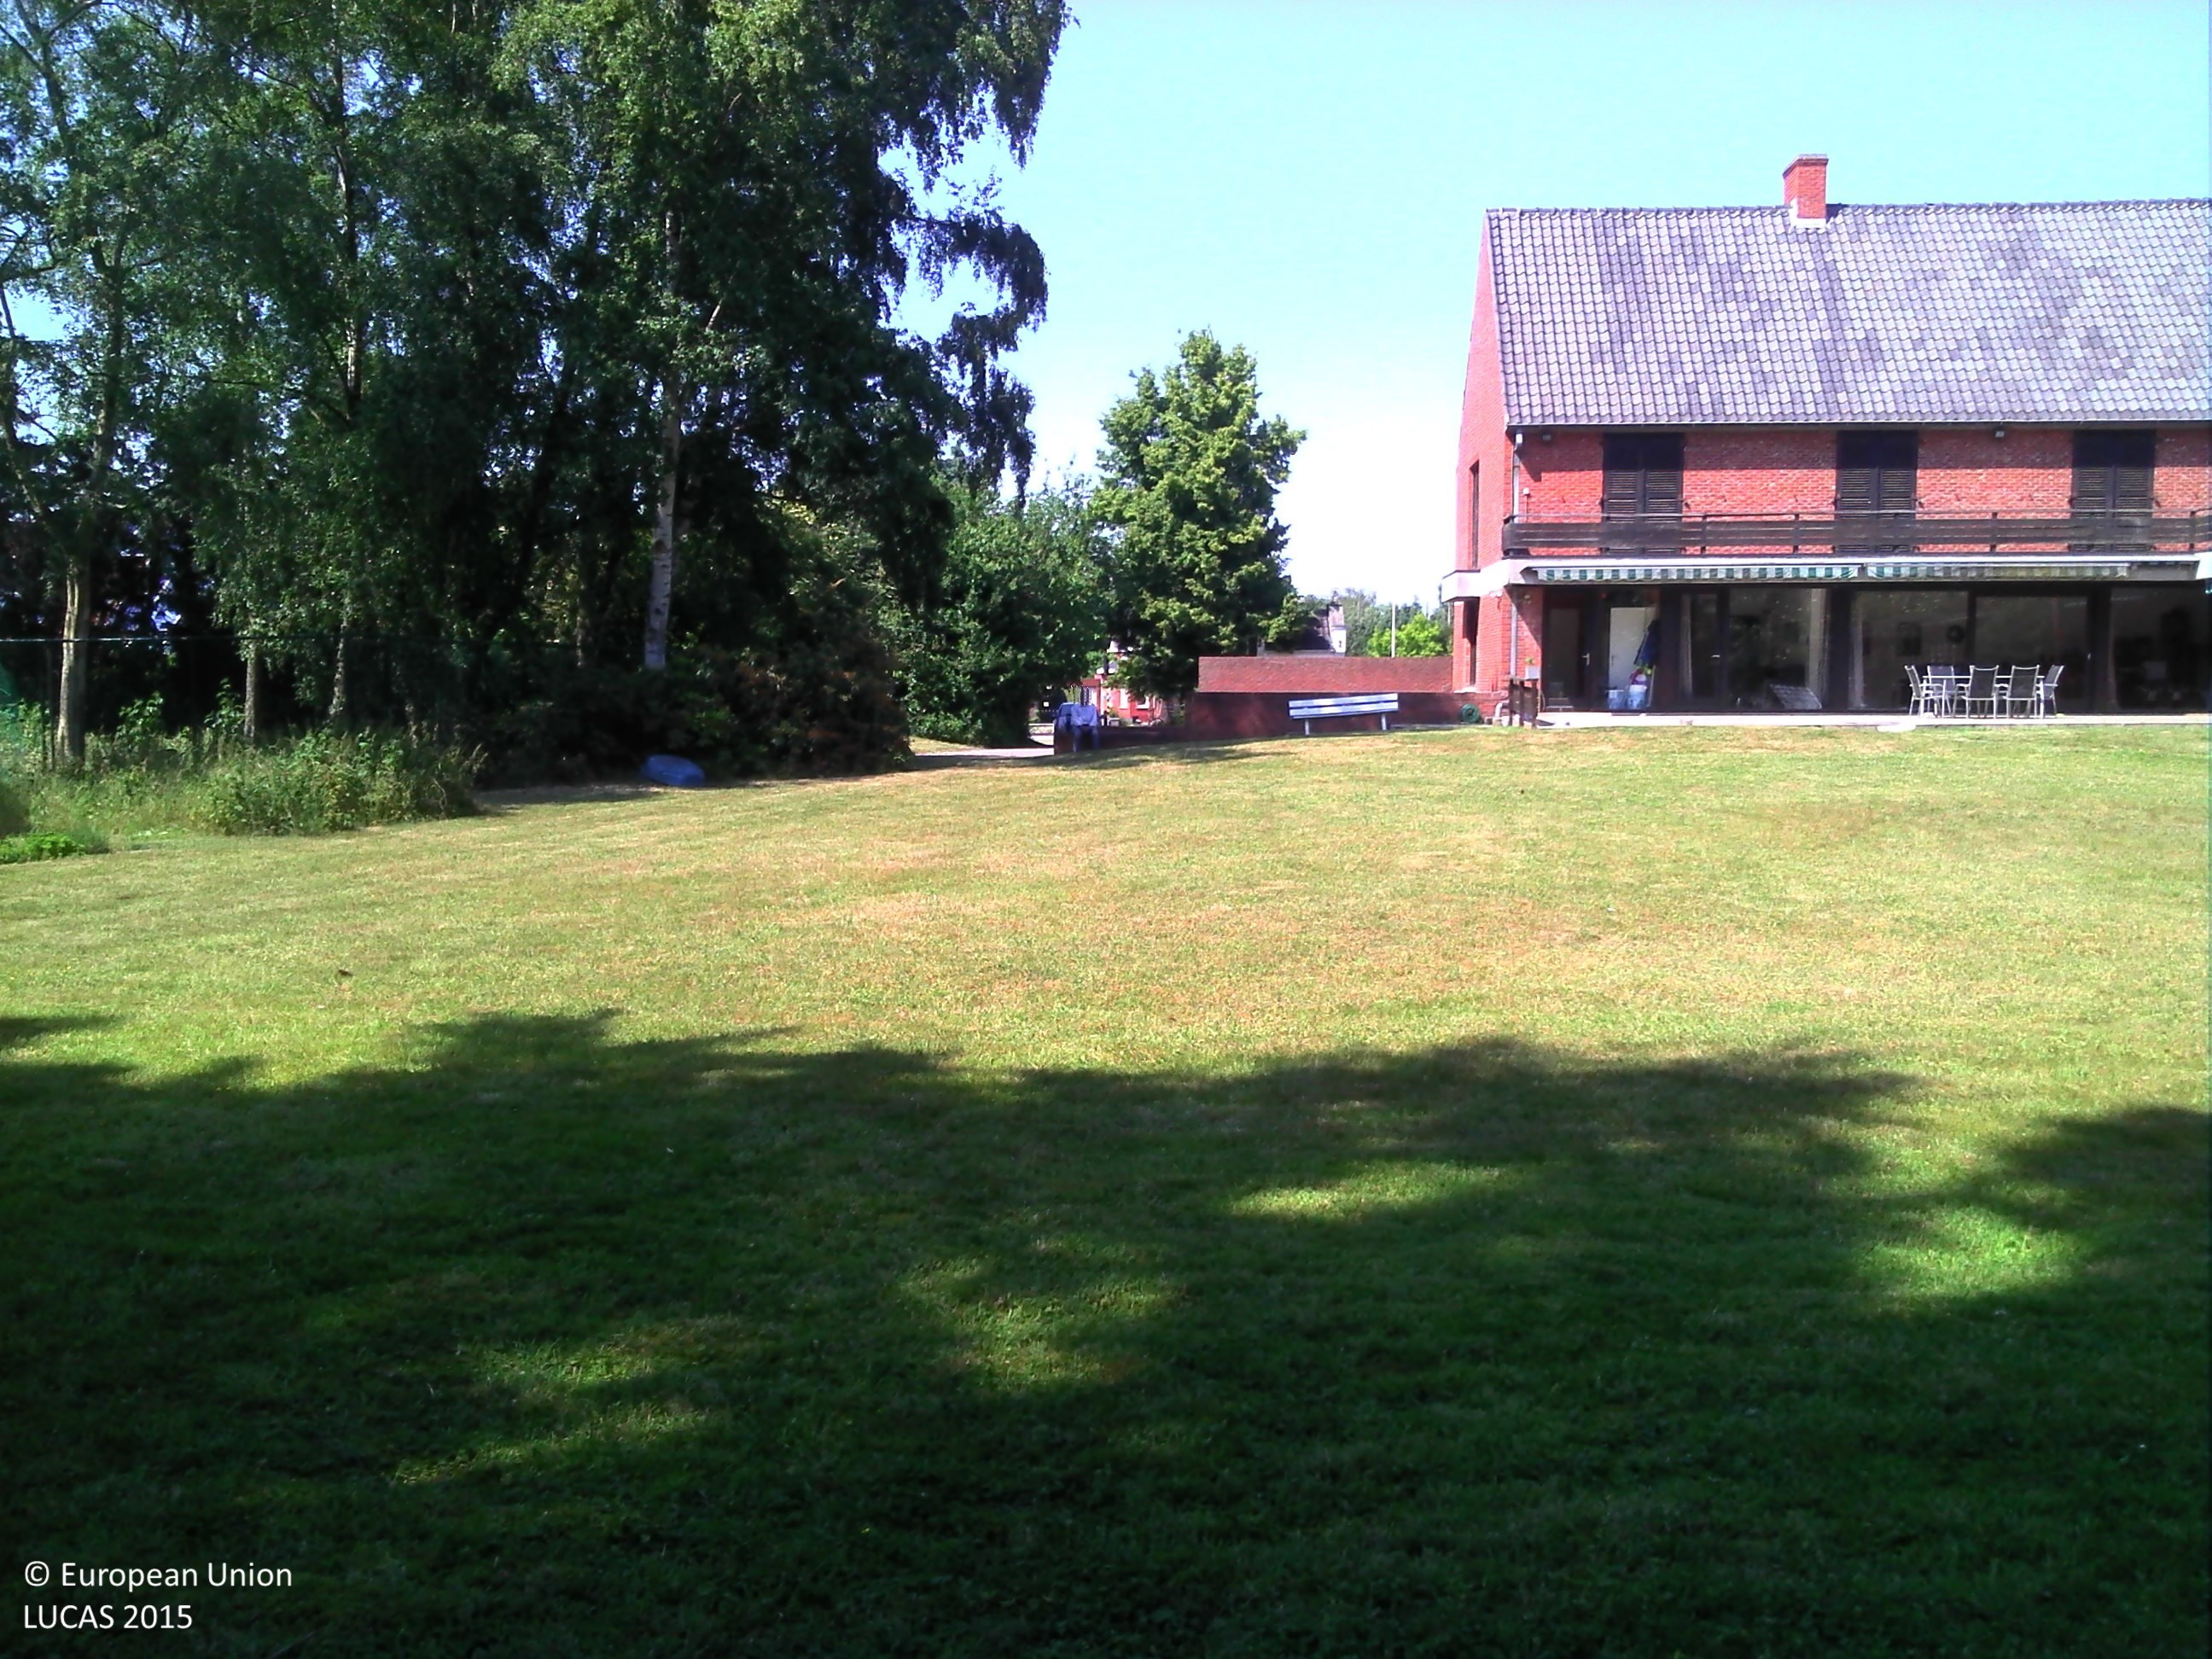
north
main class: Woodland
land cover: Other mixed woodland
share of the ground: > 75 %
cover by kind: broadleaved forest trees 70 %, coniferous forest trees 25 %, herbaceous plants 5 %
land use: Residential
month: June
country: BE
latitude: 50.9478
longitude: 5.2008
